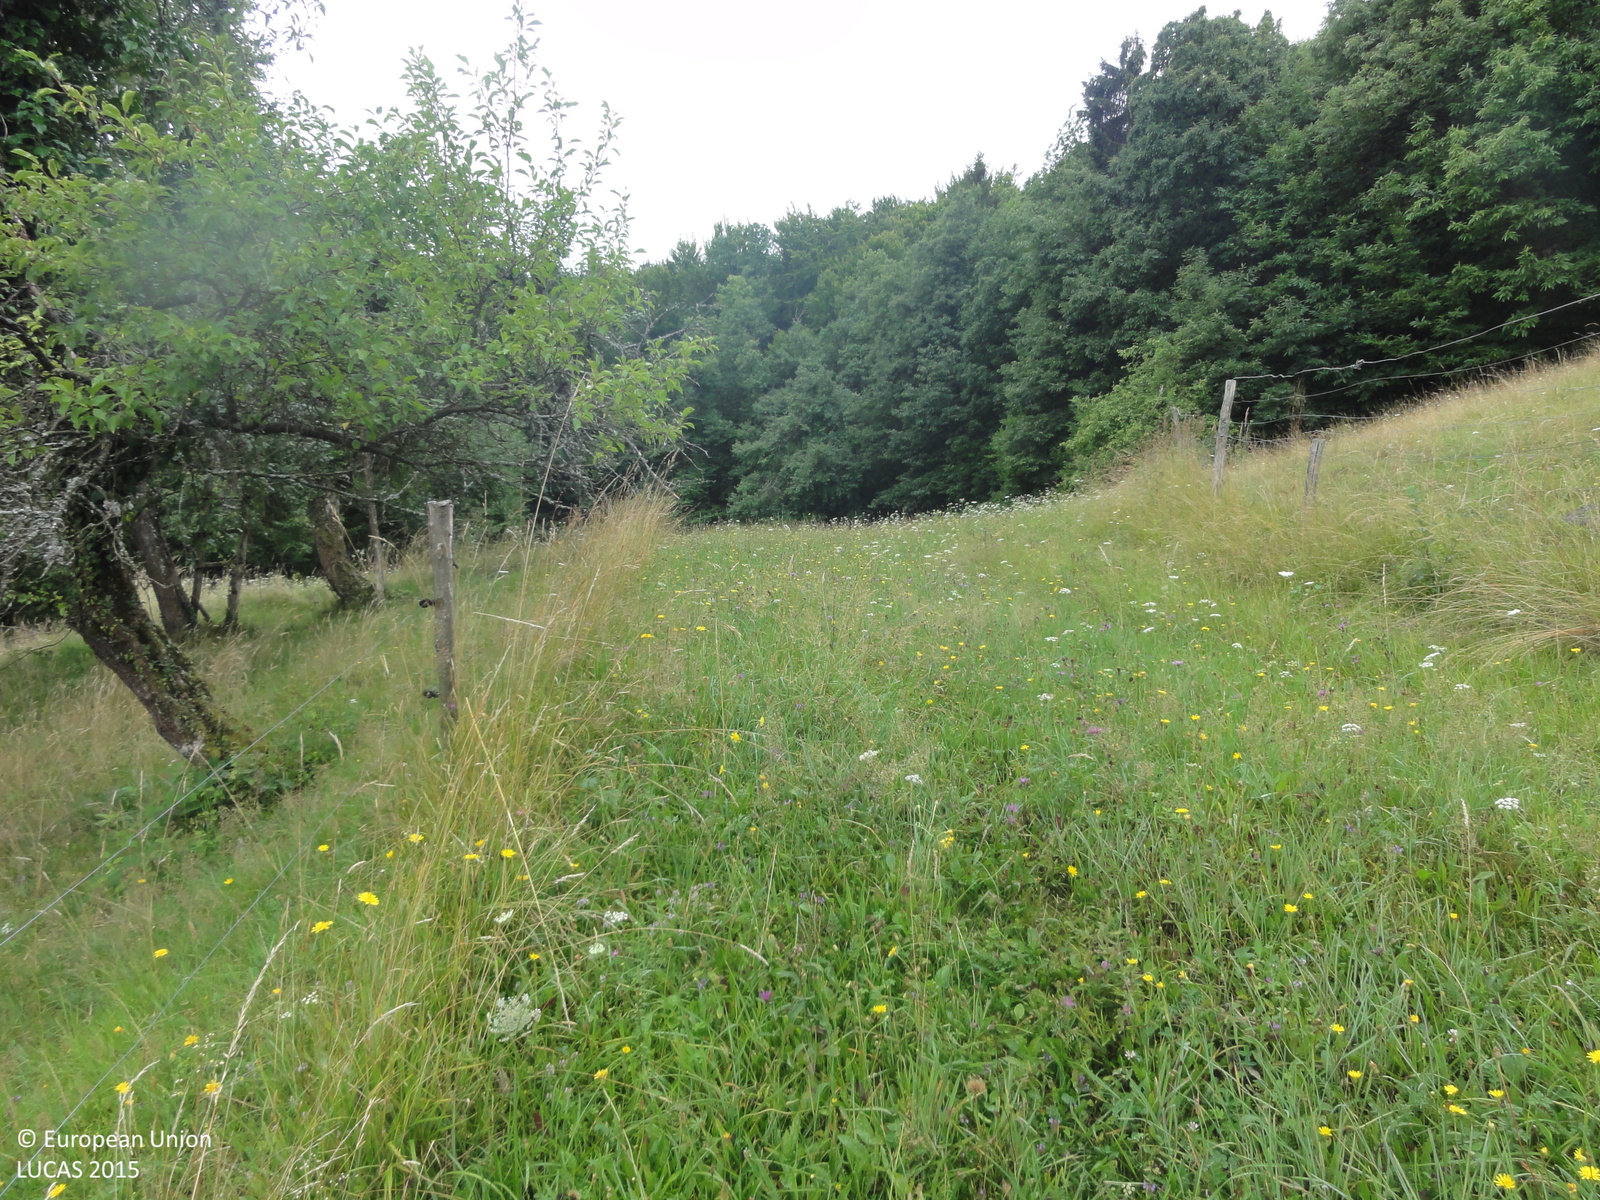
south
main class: Grassland
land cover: Grassland without tree/shrub cover
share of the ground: > 75 %
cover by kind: herbaceous plants 100 %
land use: Agriculture (excluding fallow land and kitchen gardens)
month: July
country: SI
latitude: 46.0095
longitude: 14.7880
